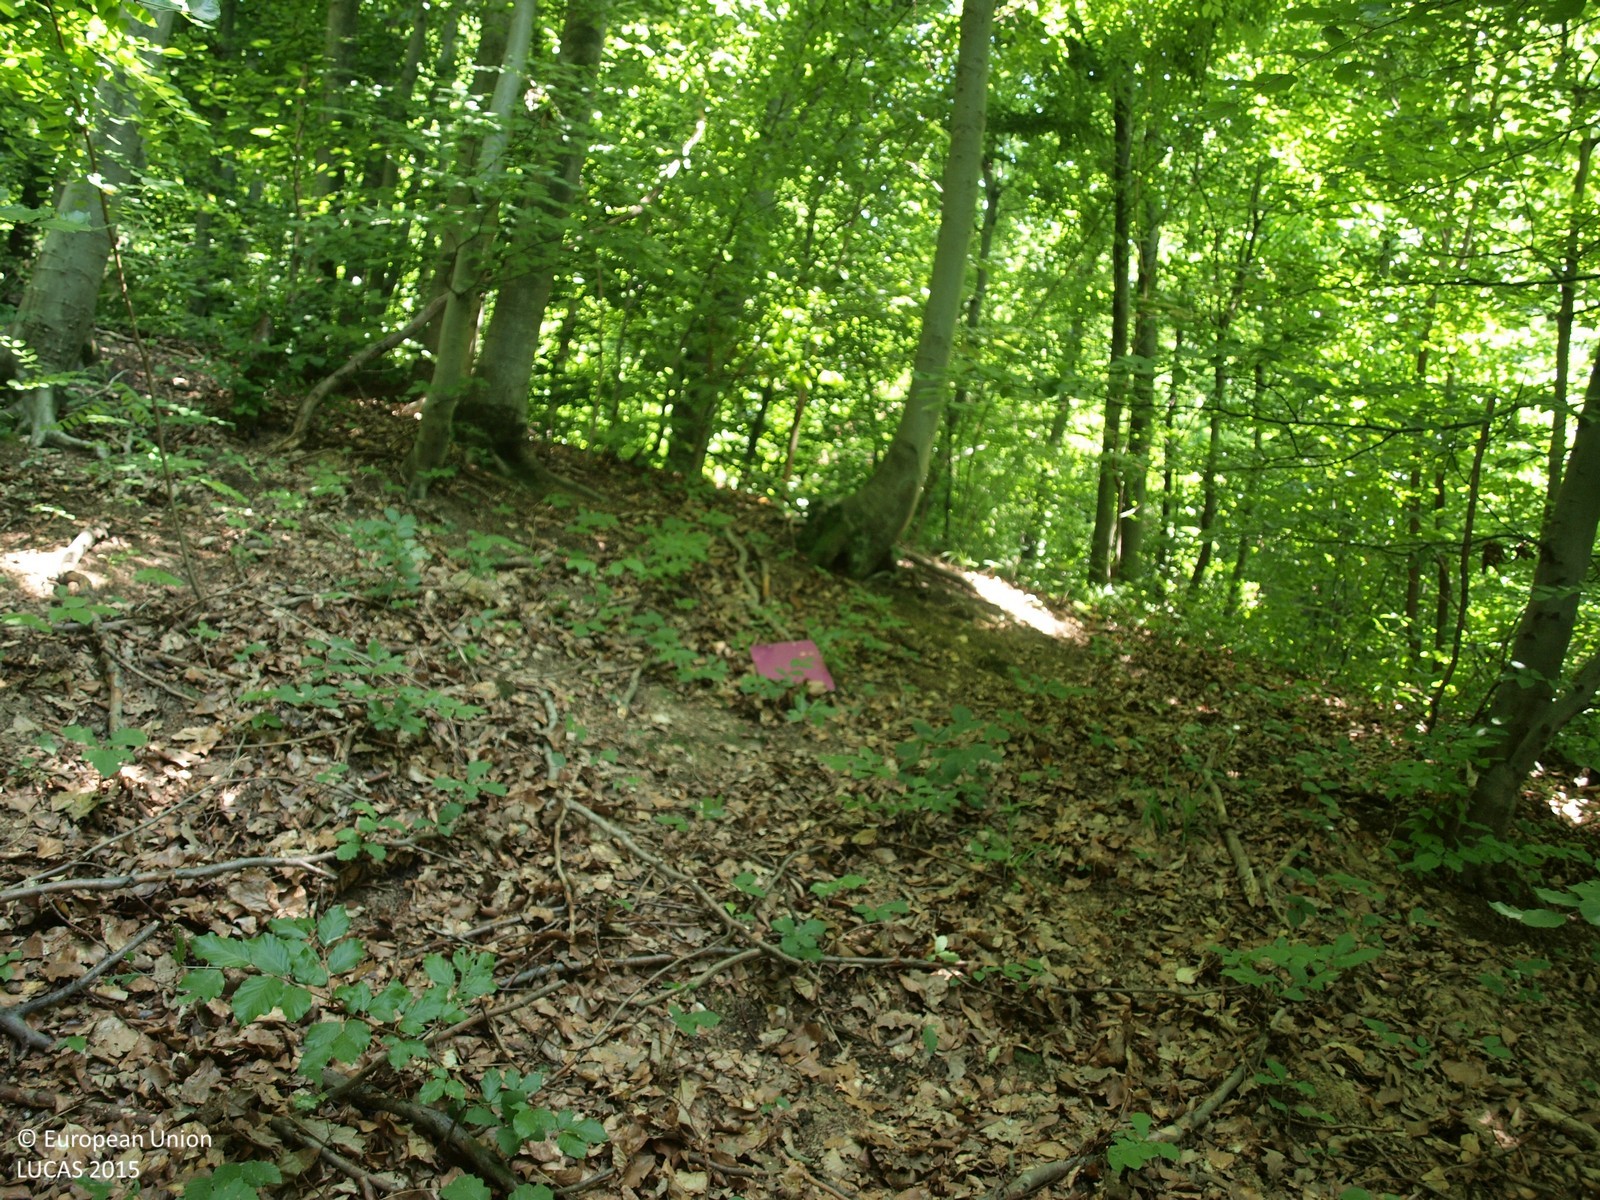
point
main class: Woodland
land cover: Broadleaved woodland
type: beech forest
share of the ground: > 75 %
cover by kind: broadleaved forest trees 100 %
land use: Forestry
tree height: > 5 m
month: July
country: HR
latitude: 45.7455
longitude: 15.7428
